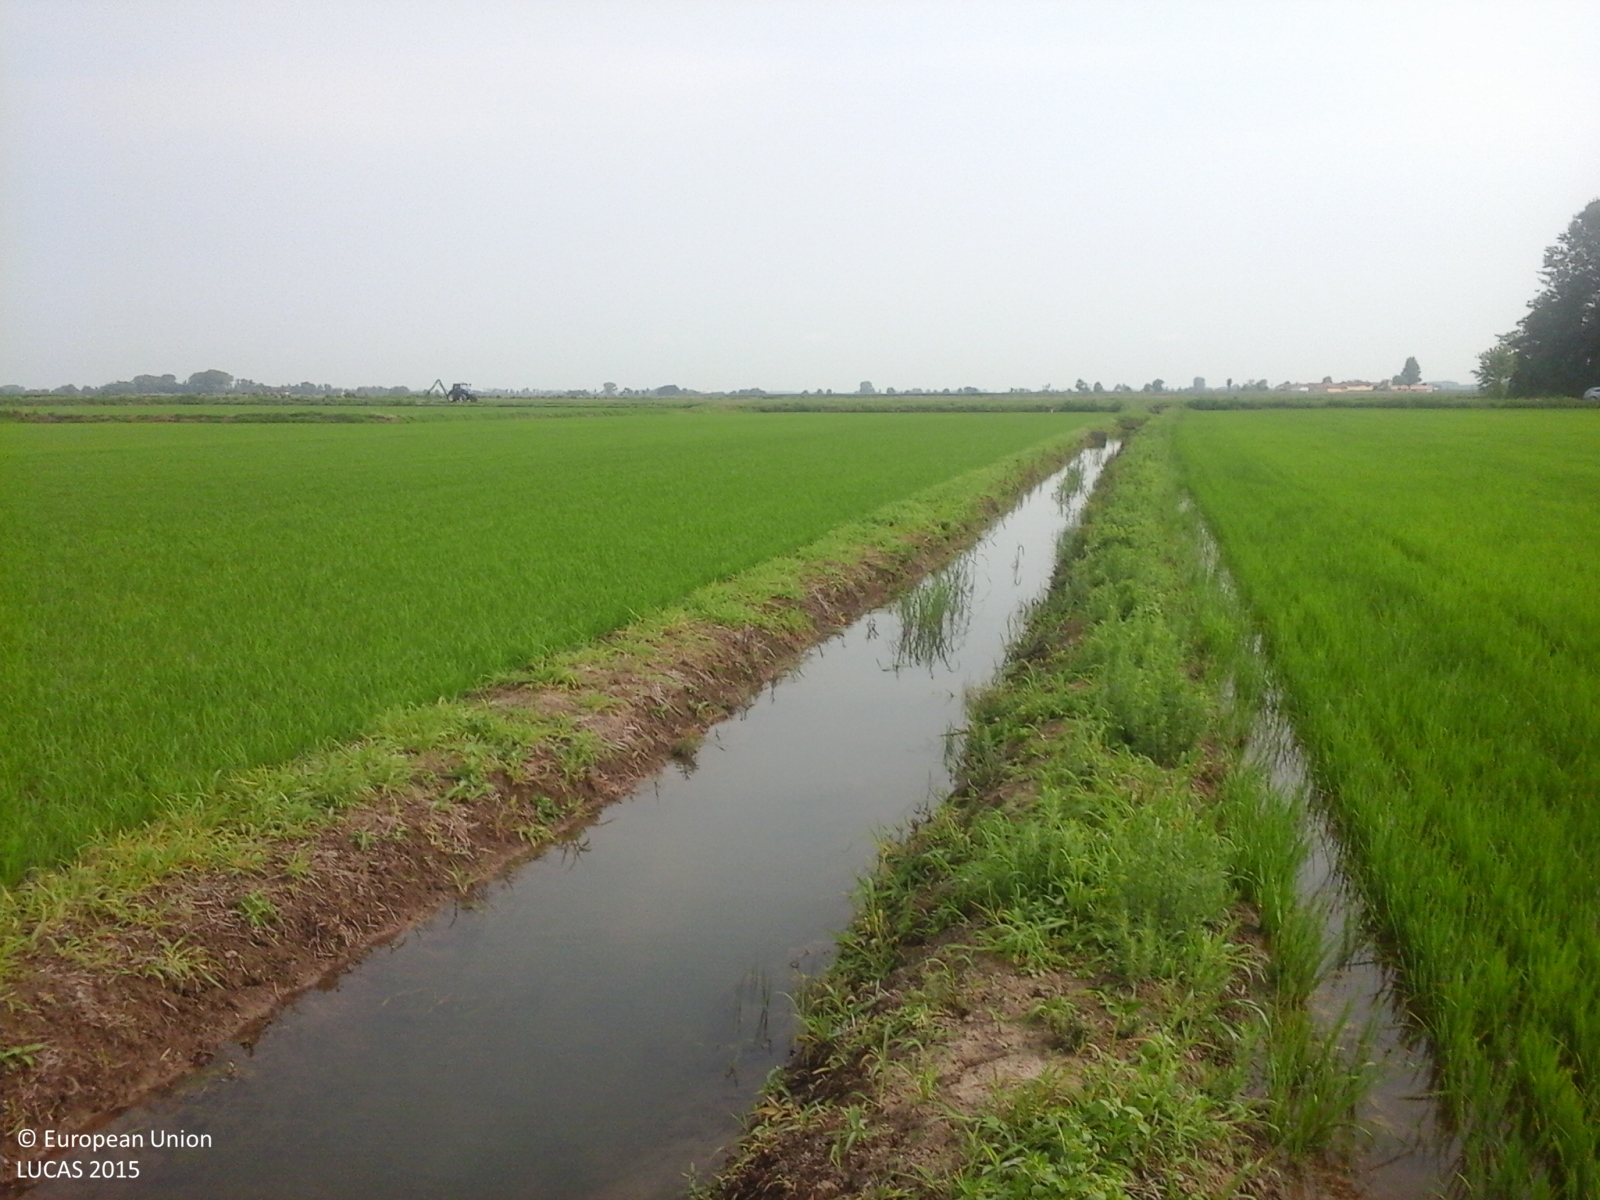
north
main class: Cropland
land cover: Rice
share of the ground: > 75 %
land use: Agriculture (excluding fallow land and kitchen gardens)
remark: Temporary flooded
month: June
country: IT
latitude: 45.1352
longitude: 8.6419
